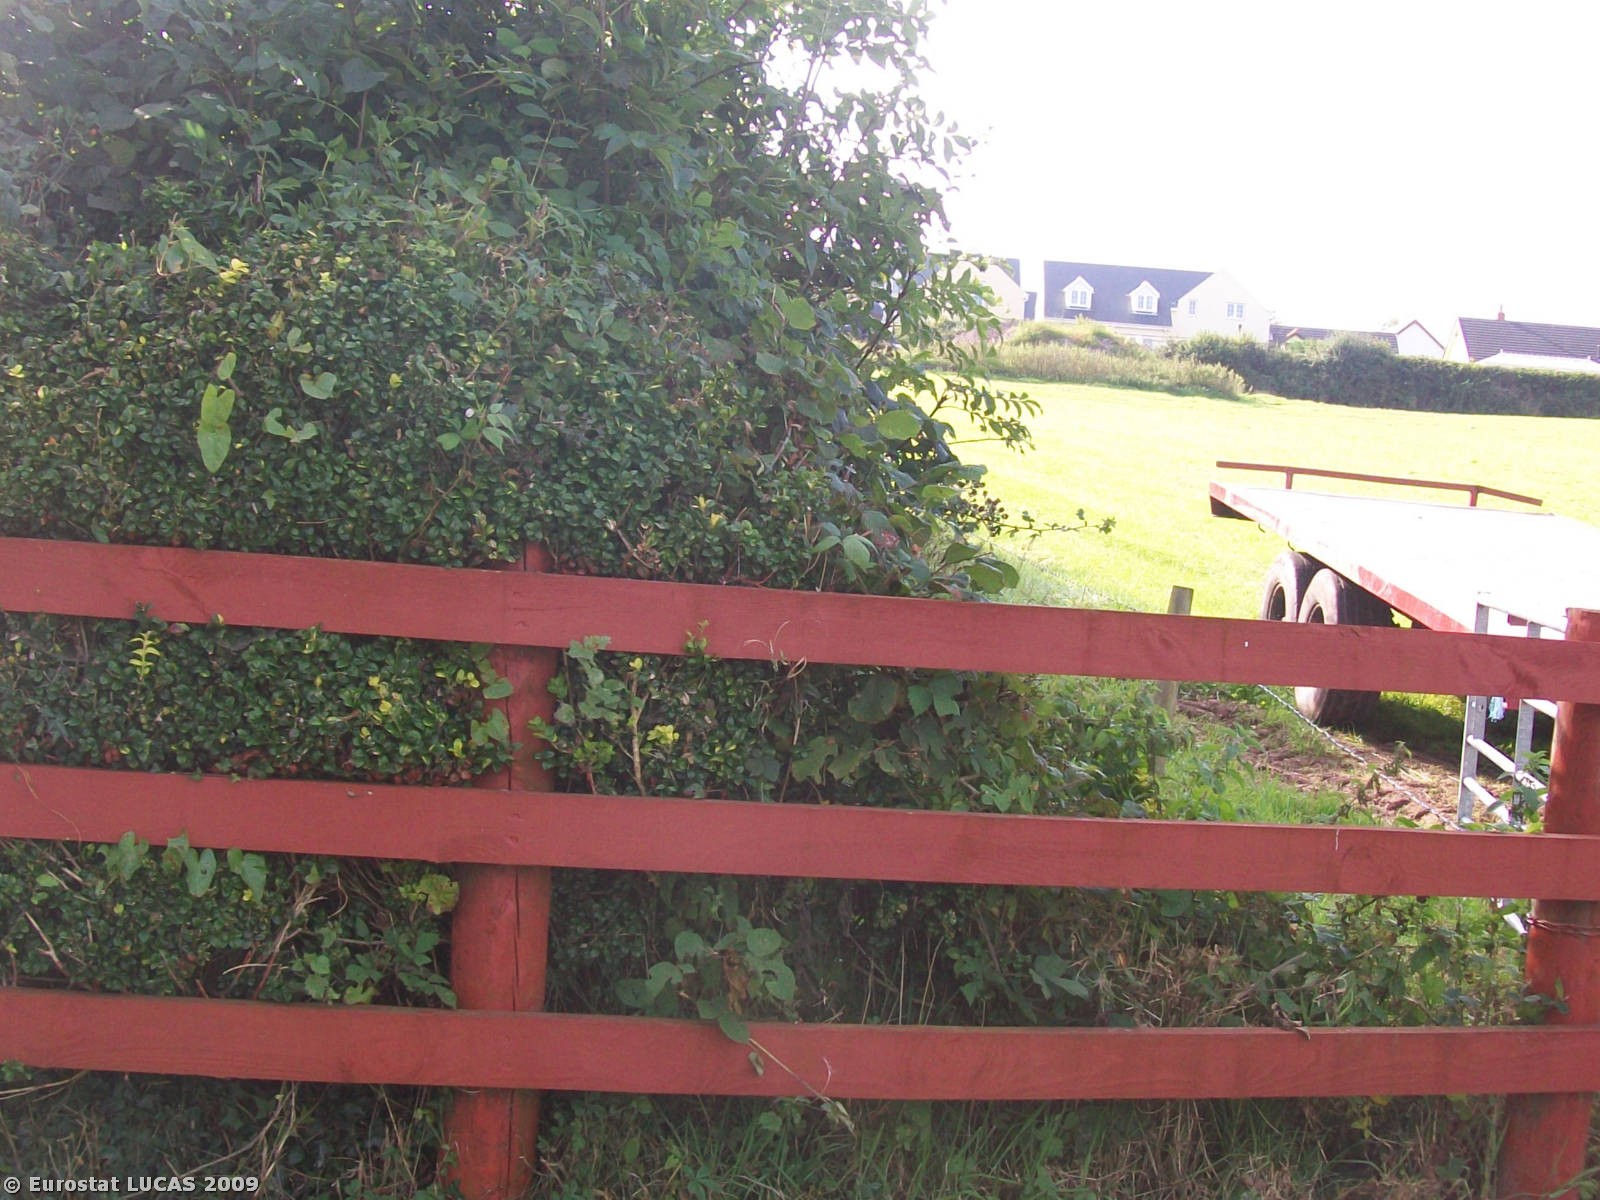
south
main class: Grassland
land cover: Grassland without tree/shrub cover
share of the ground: > 75 %
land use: Agriculture (excluding fallow land and kitchen gardens)
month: September
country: GB
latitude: 51.7836
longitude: -4.7076
